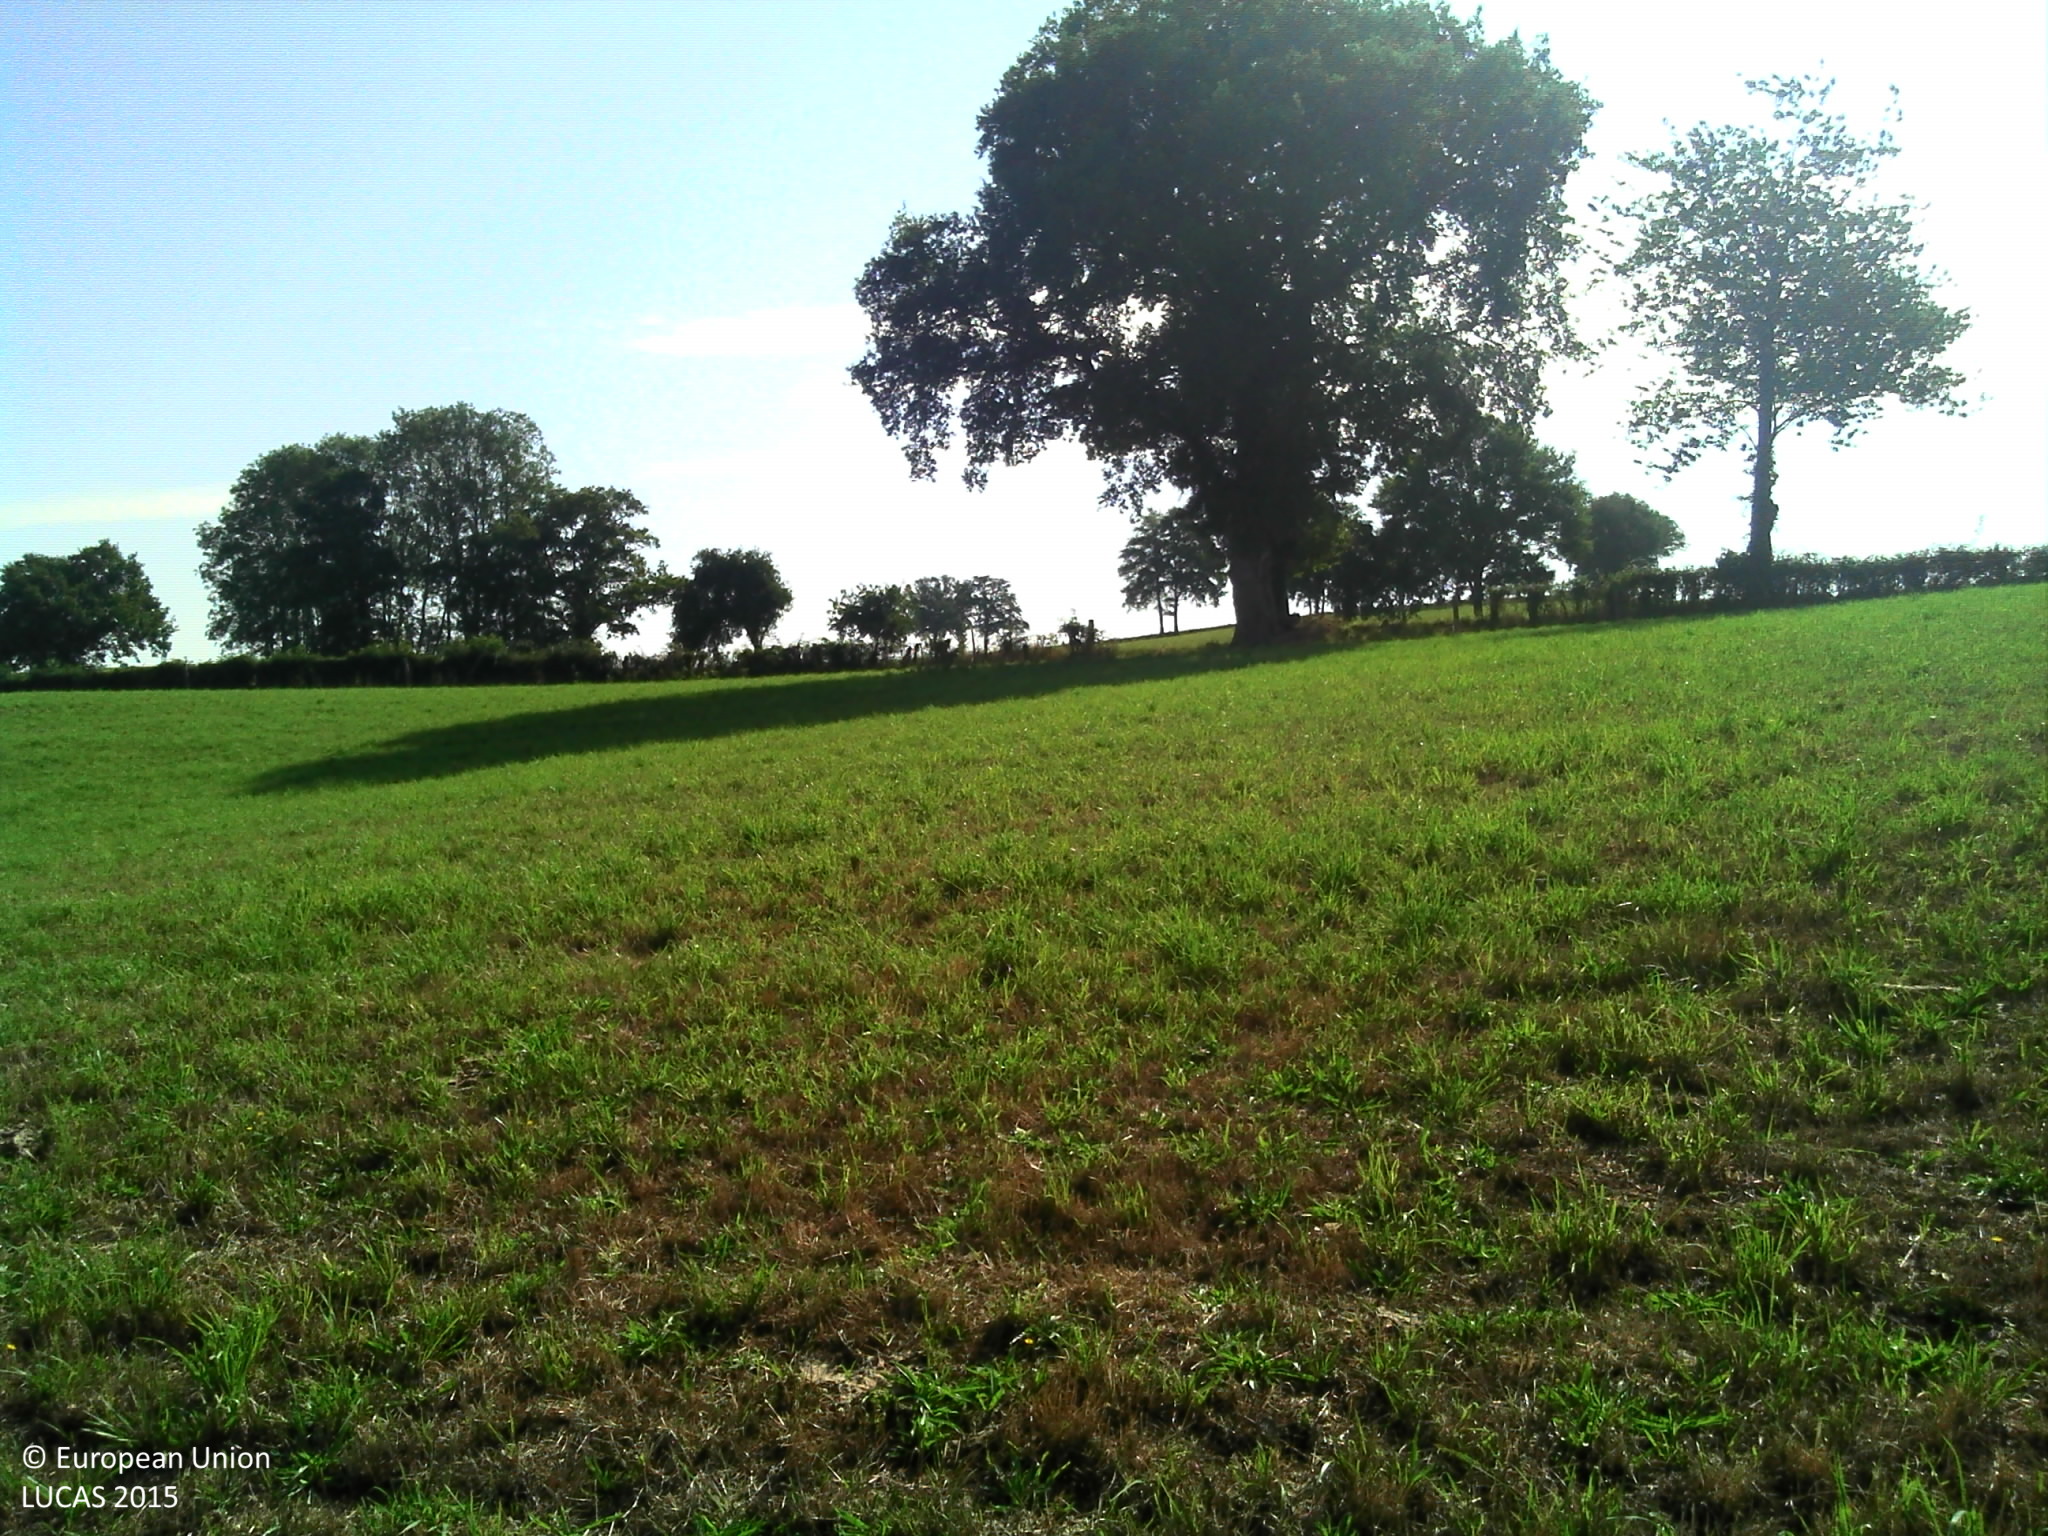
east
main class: Cropland
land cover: Temporary grasslands
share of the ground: > 75 %
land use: Agriculture (excluding fallow land and kitchen gardens)
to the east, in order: Temporary grasslands; Fences; Broadleaved woodland; Fences; Temporary grasslands; Fences; Tracks; Broadleaved woodland; Temporary grasslands; Fences; Lines of trees; Temporary grasslands
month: August
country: FR
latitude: 46.1881
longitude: 1.6609
